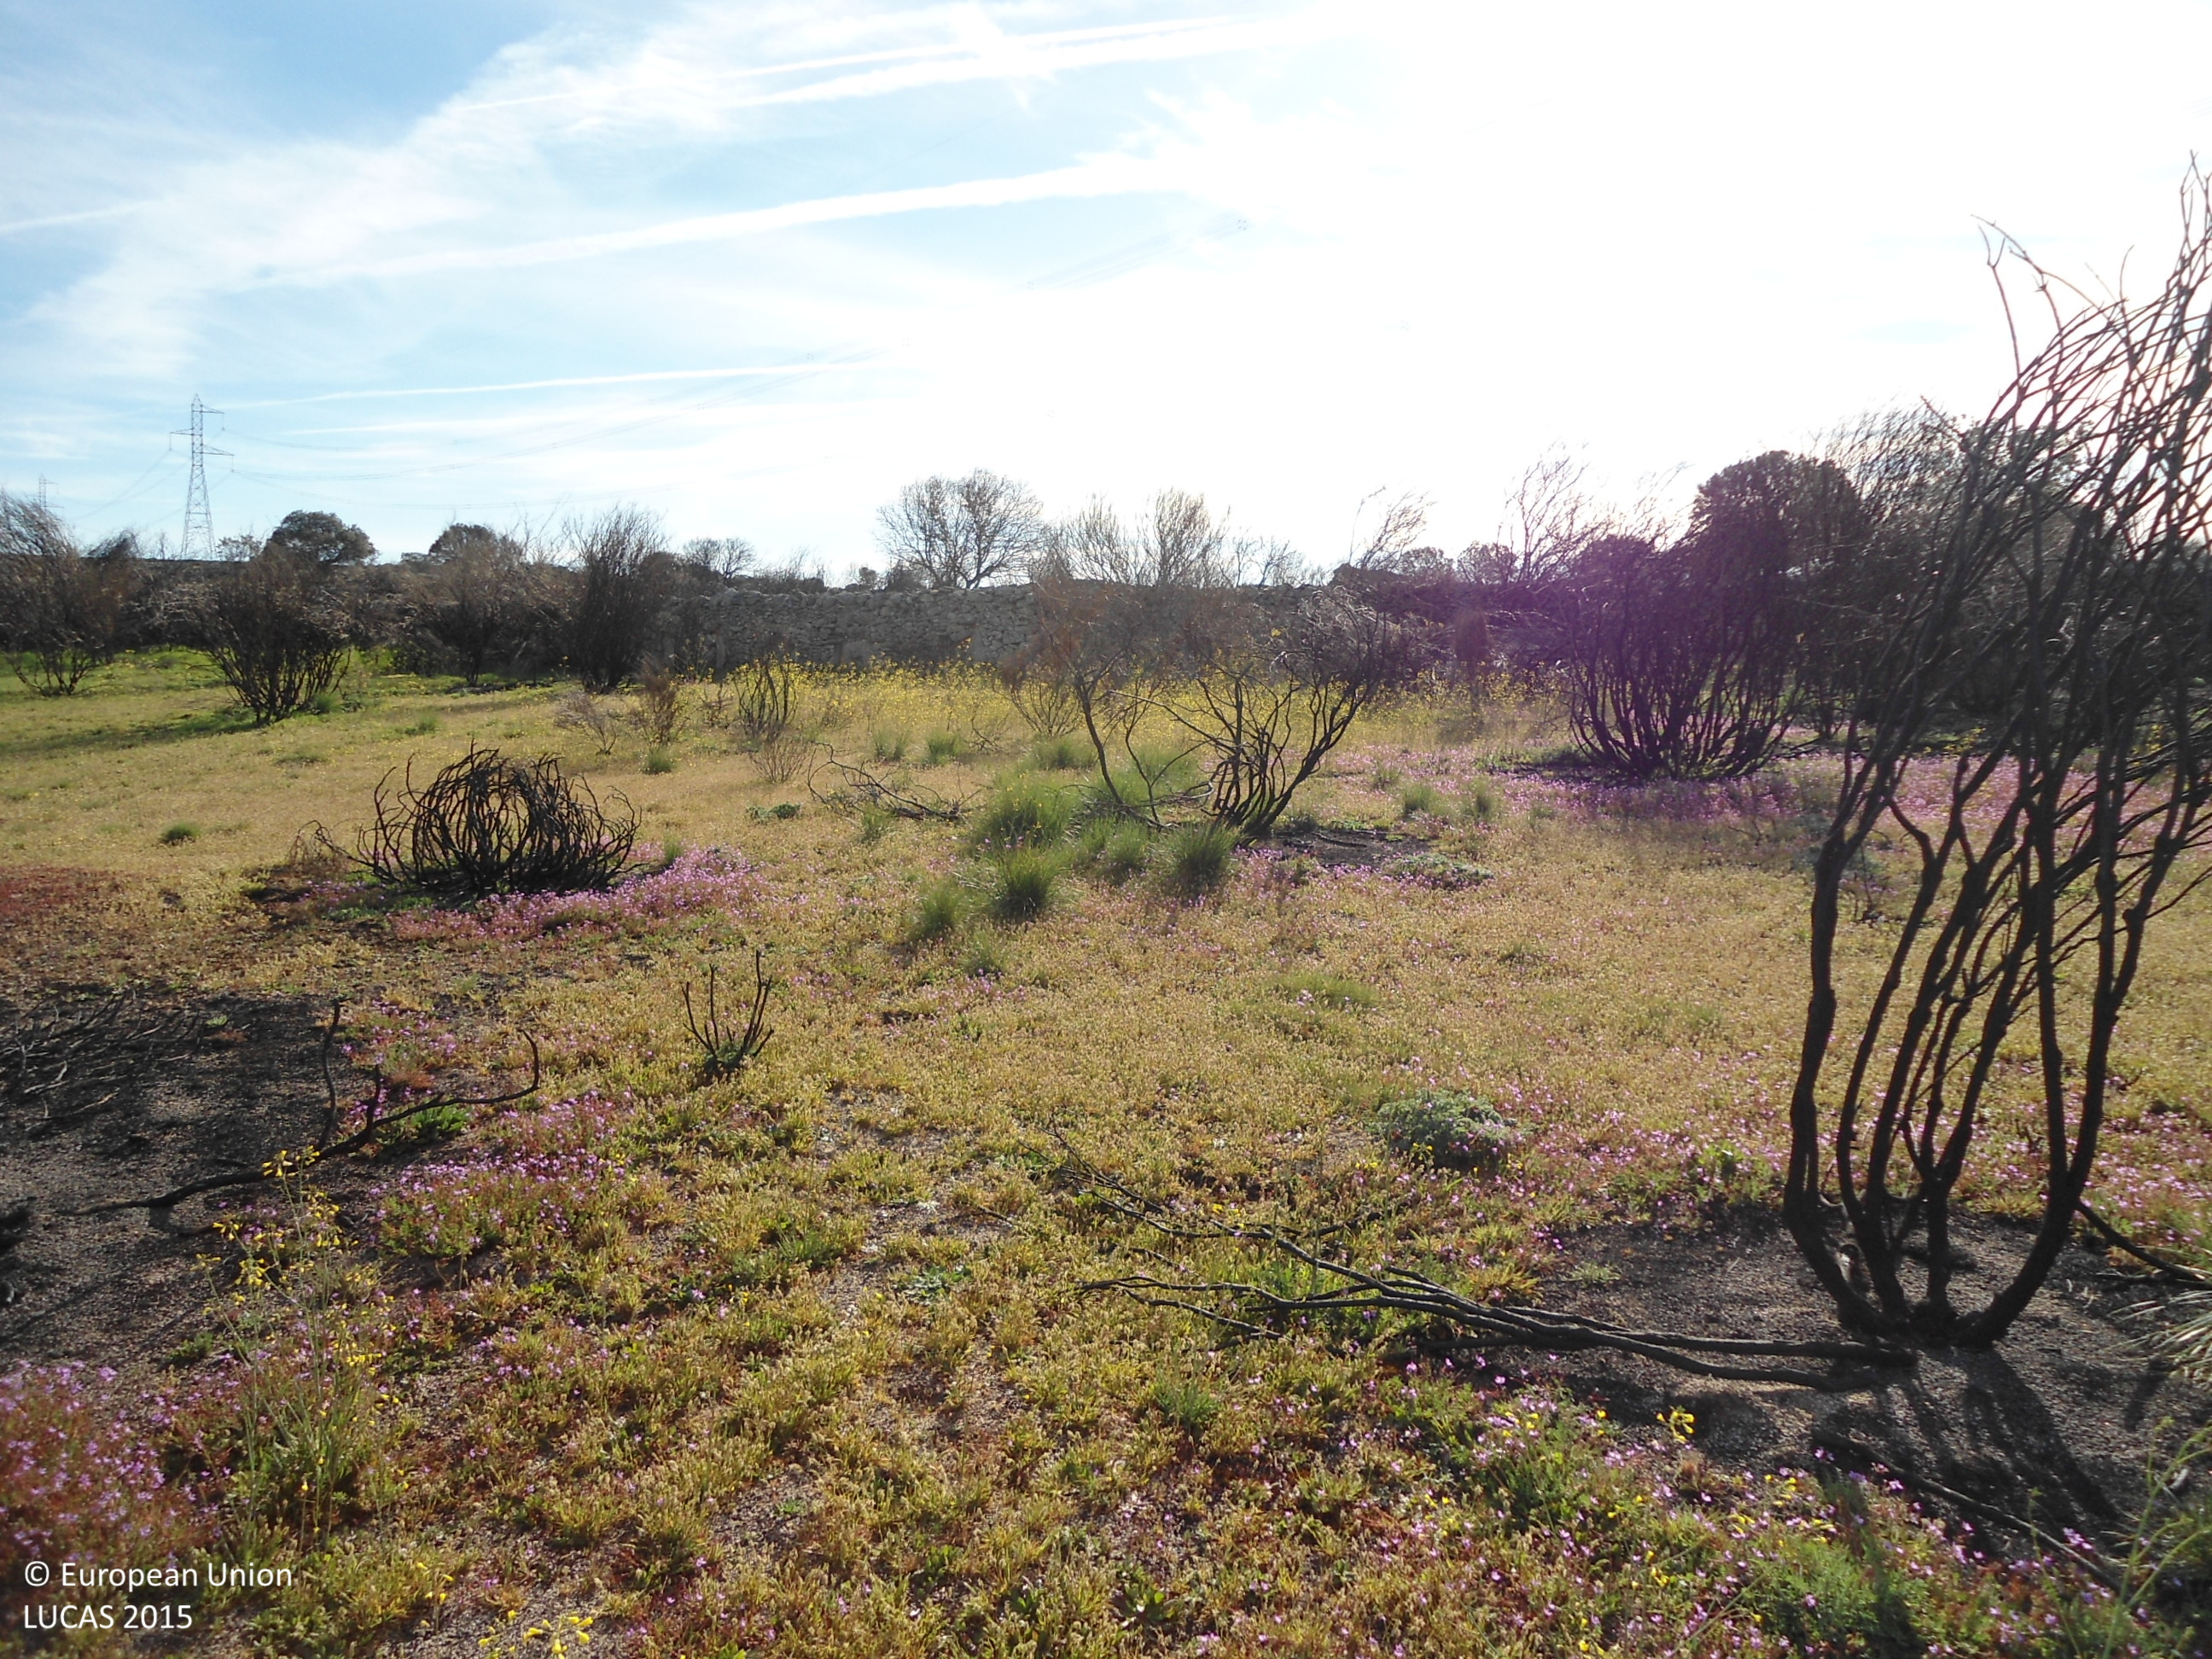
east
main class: Grassland
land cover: Grassland without tree/shrub cover
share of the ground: > 75 %
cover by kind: herbaceous plants 100 %
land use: Agriculture (excluding fallow land and kitchen gardens)
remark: Burnt area
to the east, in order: Grassland without tree/shrub cover; Dry stone walls; Grassland without tree/shrub cover; Dry stone walls; Grassland with sparse tree/shrub cover; Dry stone walls; Grassland with sparse tree/shrub cover; Dry stone walls; Tracks; Grassland without tree/shrub cover; Electric lines; Grassland without tree/shrub cover; Dry stone walls; Grassland with sparse tree/shrub cover; Dry stone walls; Grassland with sparse tree/shrub cover; Dry stone walls; Grassland without tree/shrub cover
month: April
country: ES
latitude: 41.5267
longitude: -6.0687
